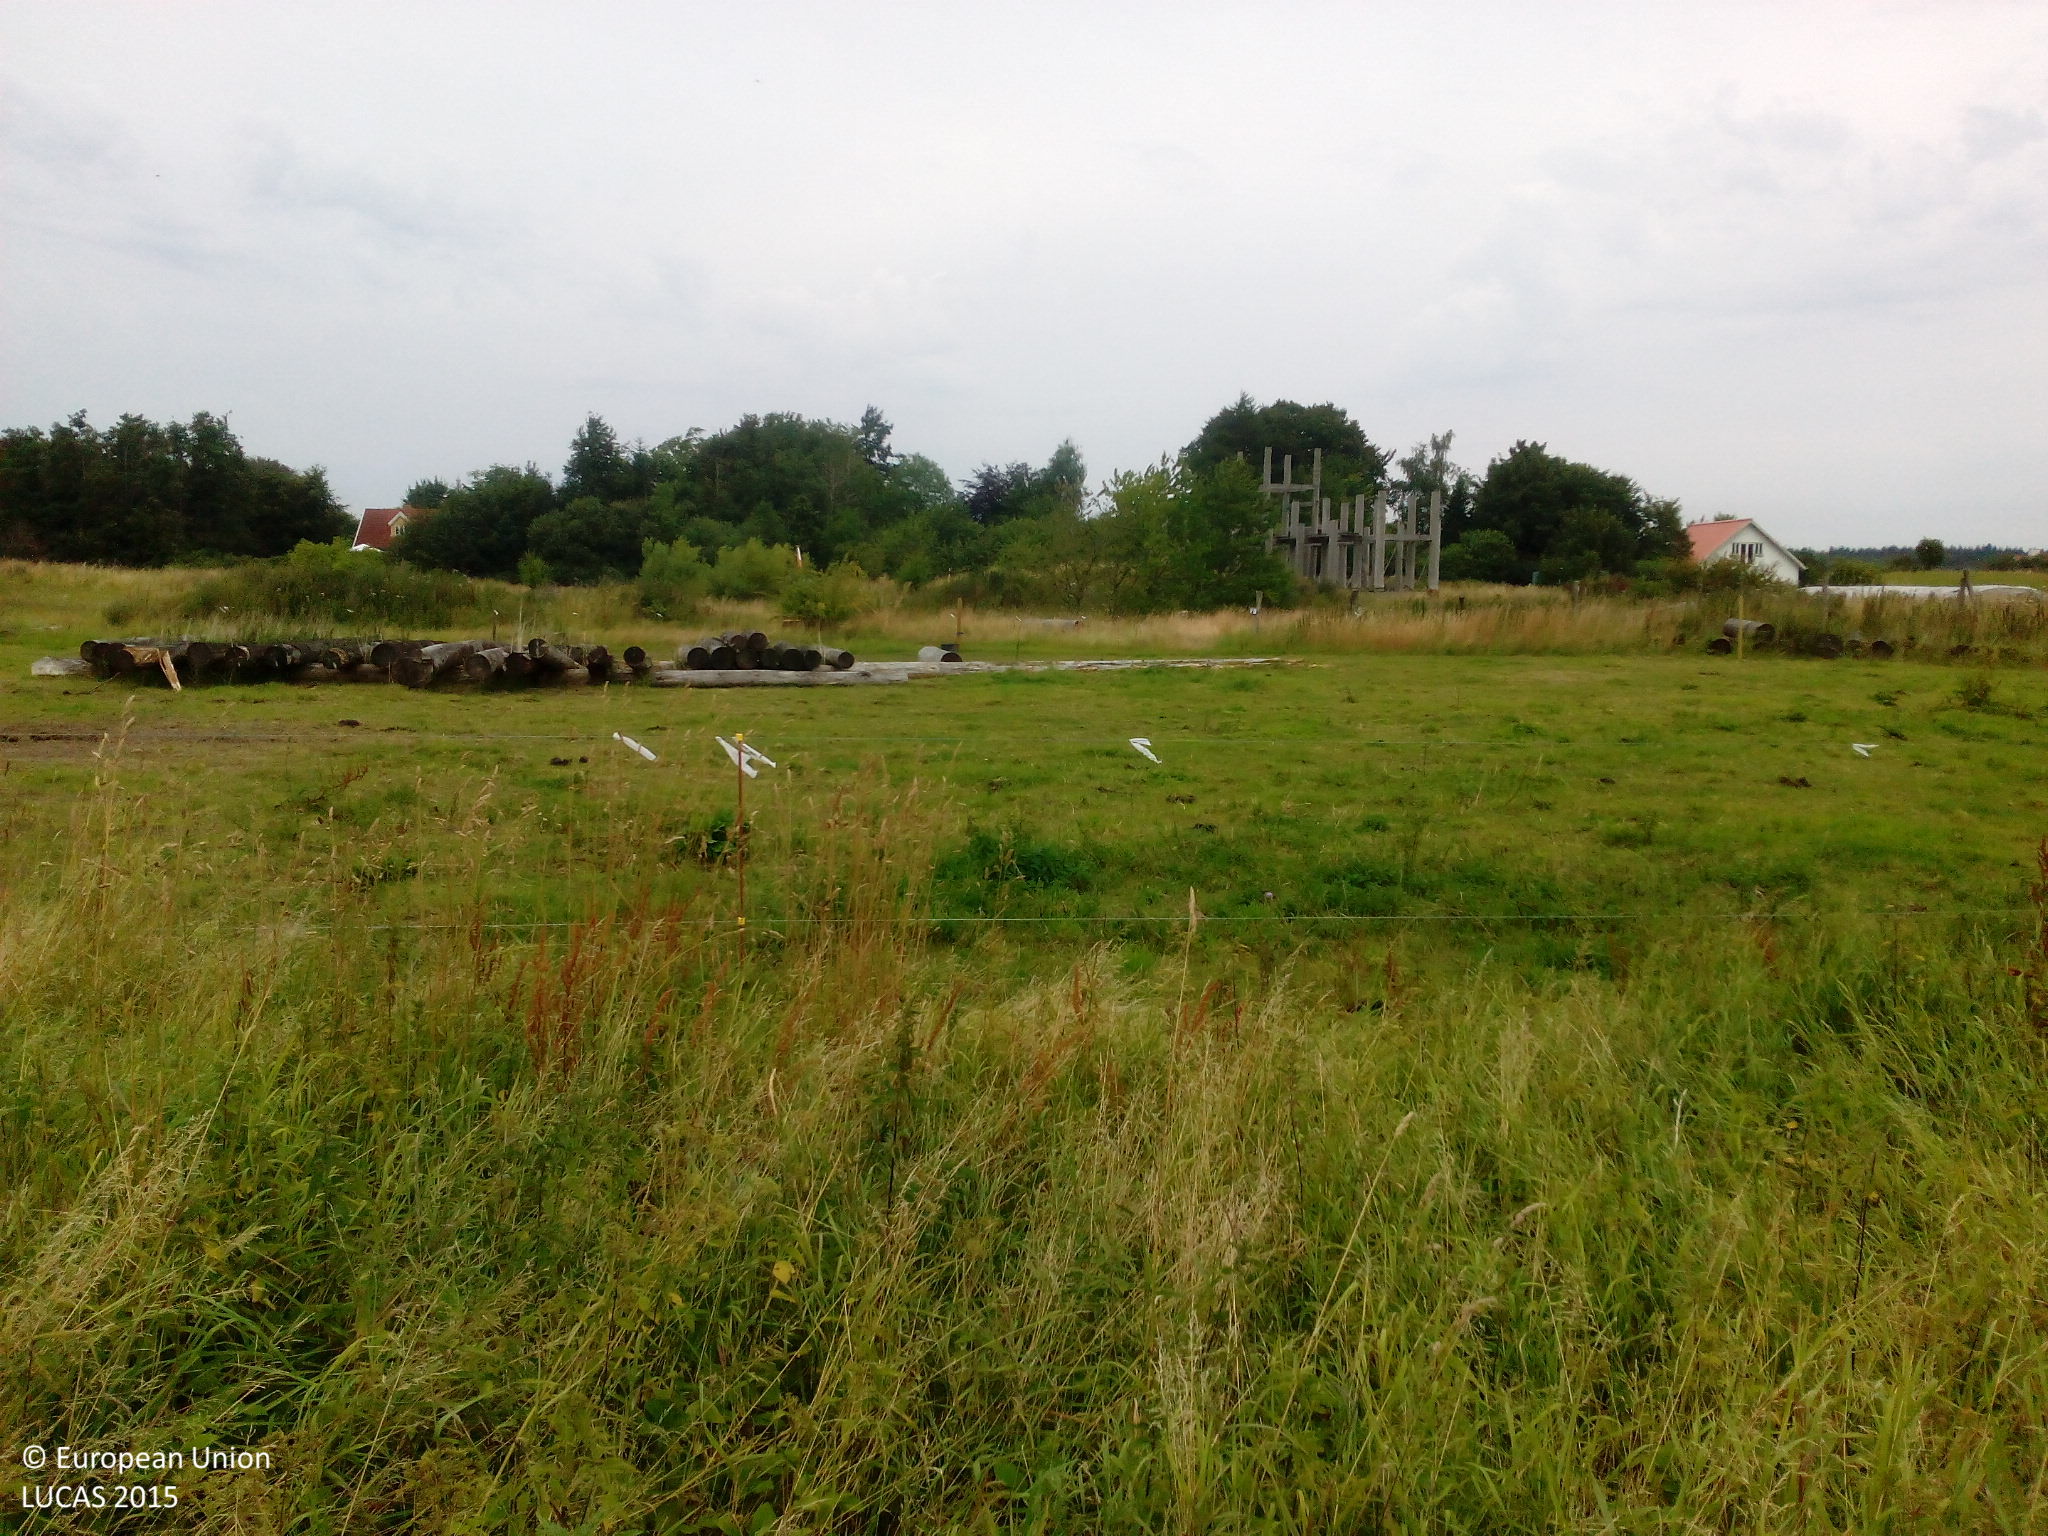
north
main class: Cropland
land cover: Rape and turnip rape
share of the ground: > 75 %
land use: Agriculture (excluding fallow land and kitchen gardens)
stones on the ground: < 10 %
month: August
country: DK
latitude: 55.5267
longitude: 11.8835
